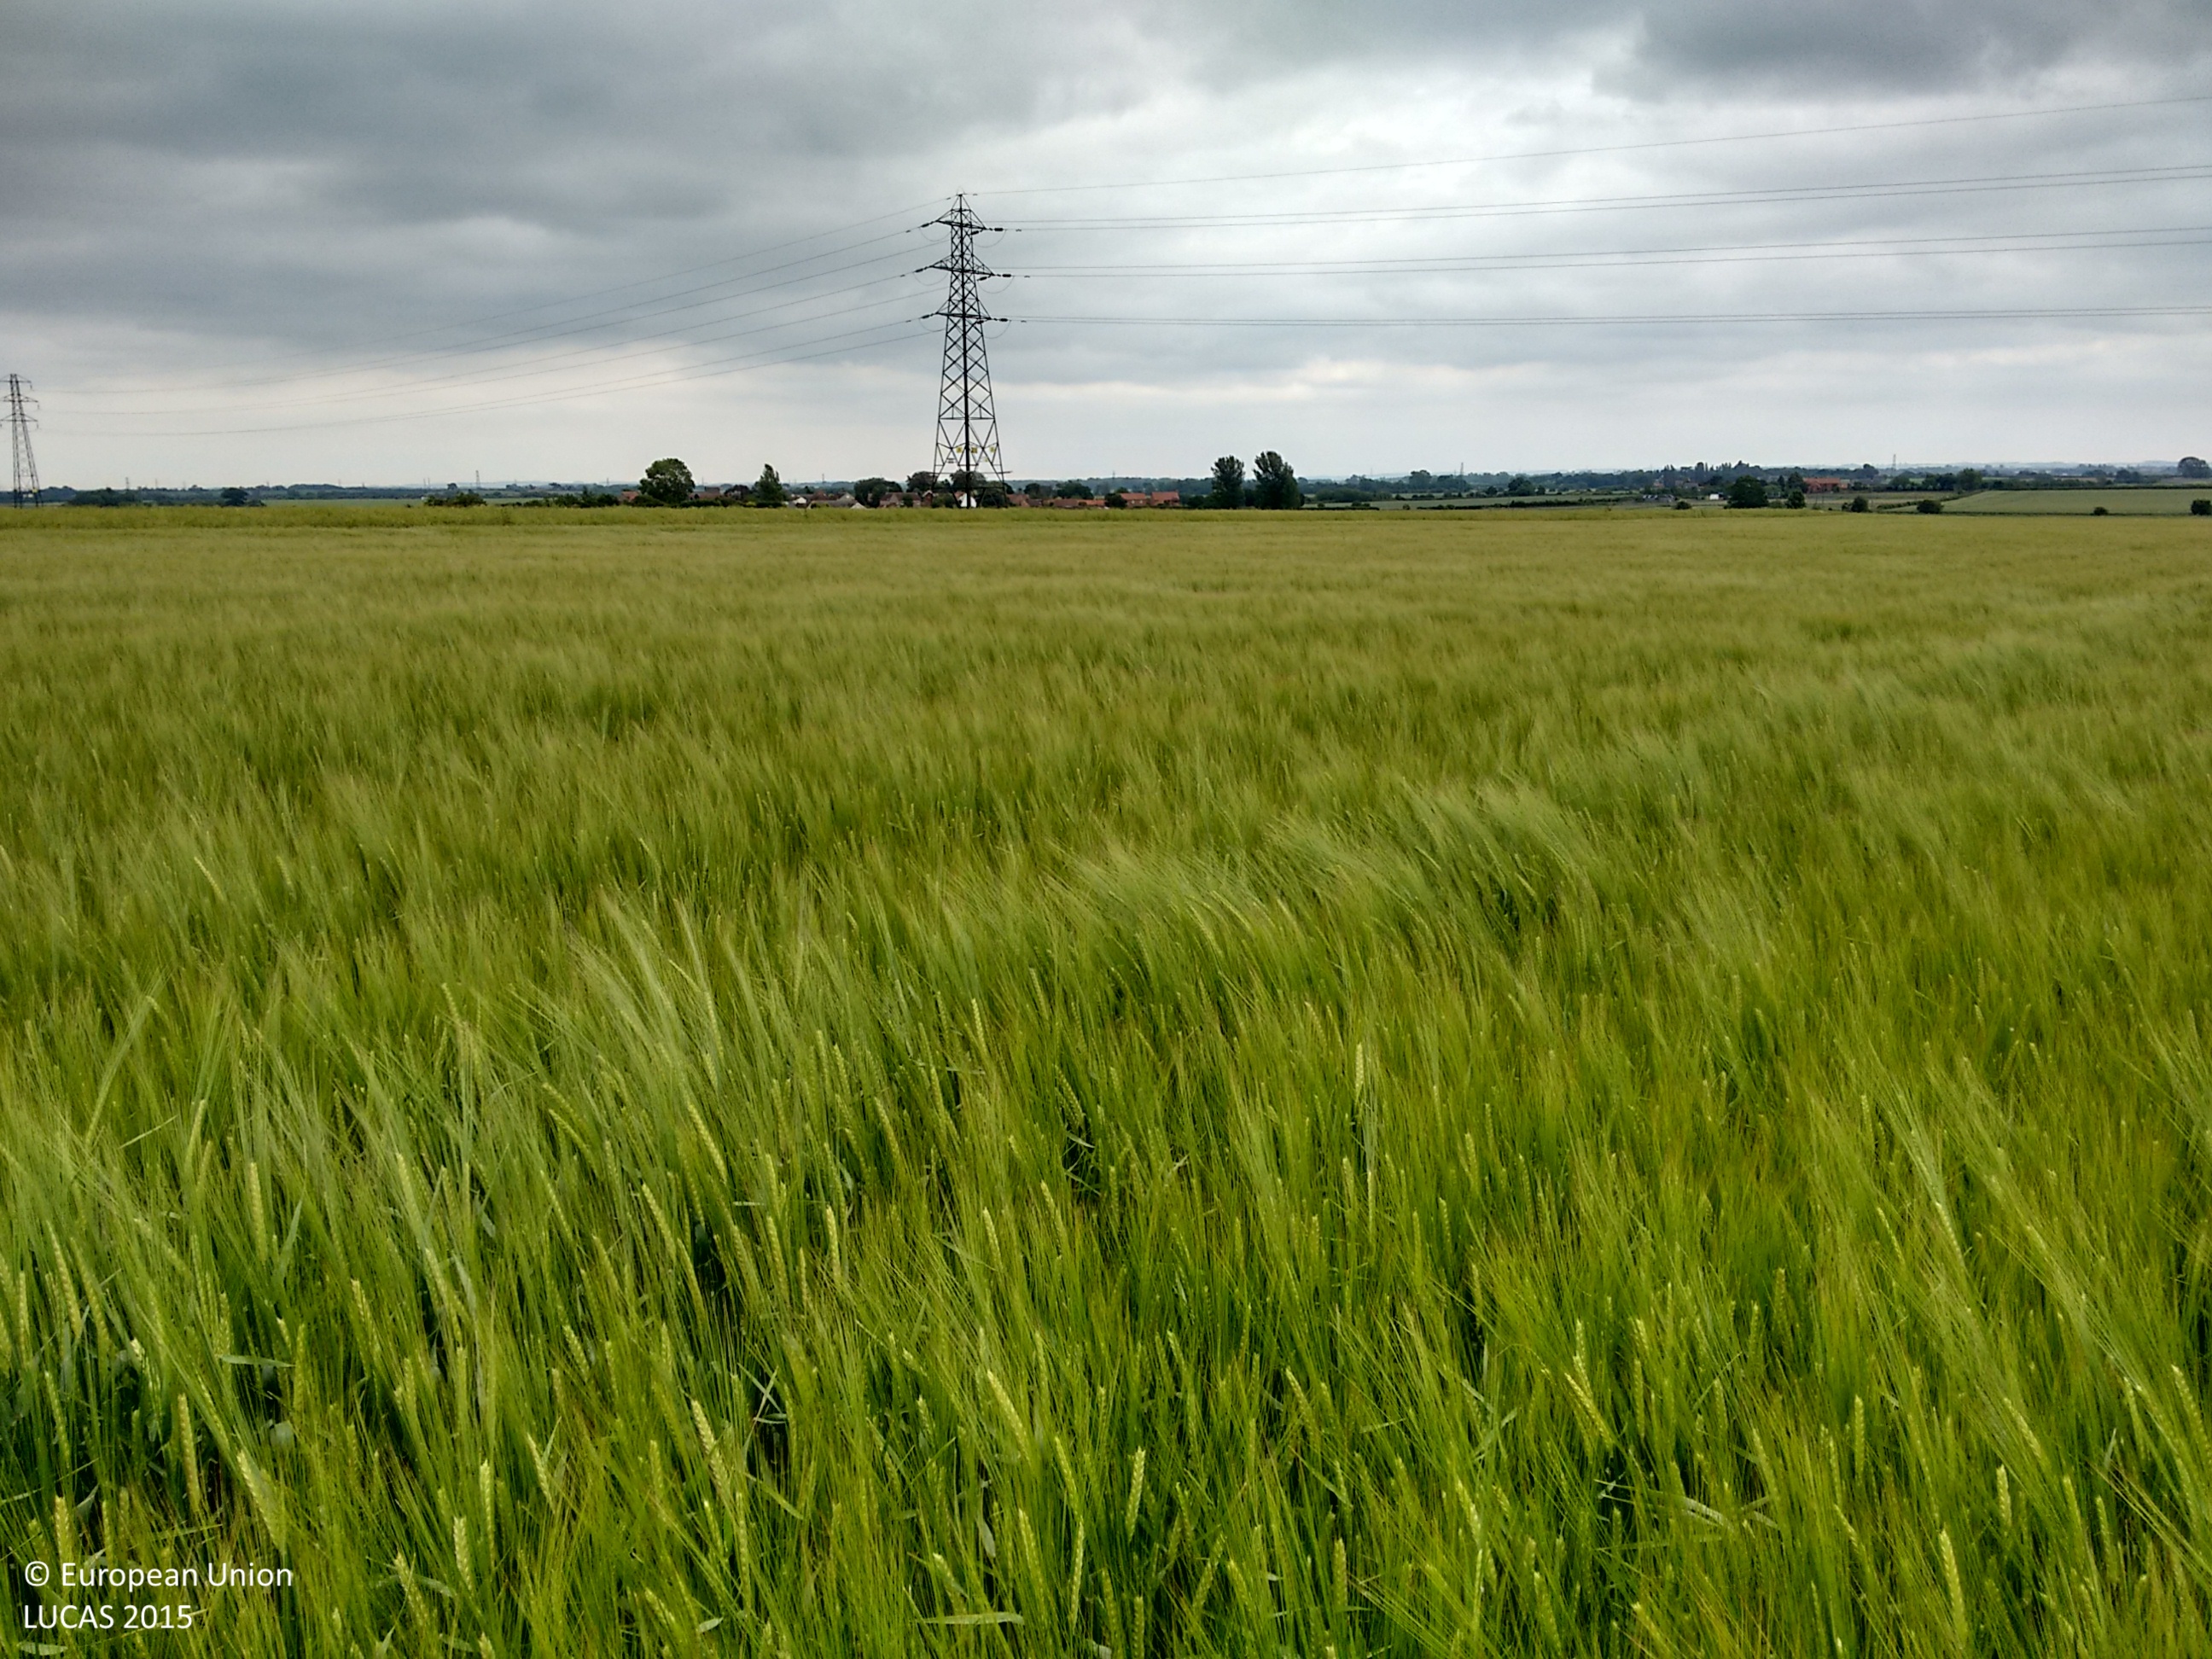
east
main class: Cropland
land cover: Barley
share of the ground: > 75 %
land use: Agriculture (excluding fallow land and kitchen gardens)
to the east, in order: Barley; Rape and turnip rape; Electric lines; Rape and turnip rape
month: June
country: GB
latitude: 53.0013
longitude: -0.8753
